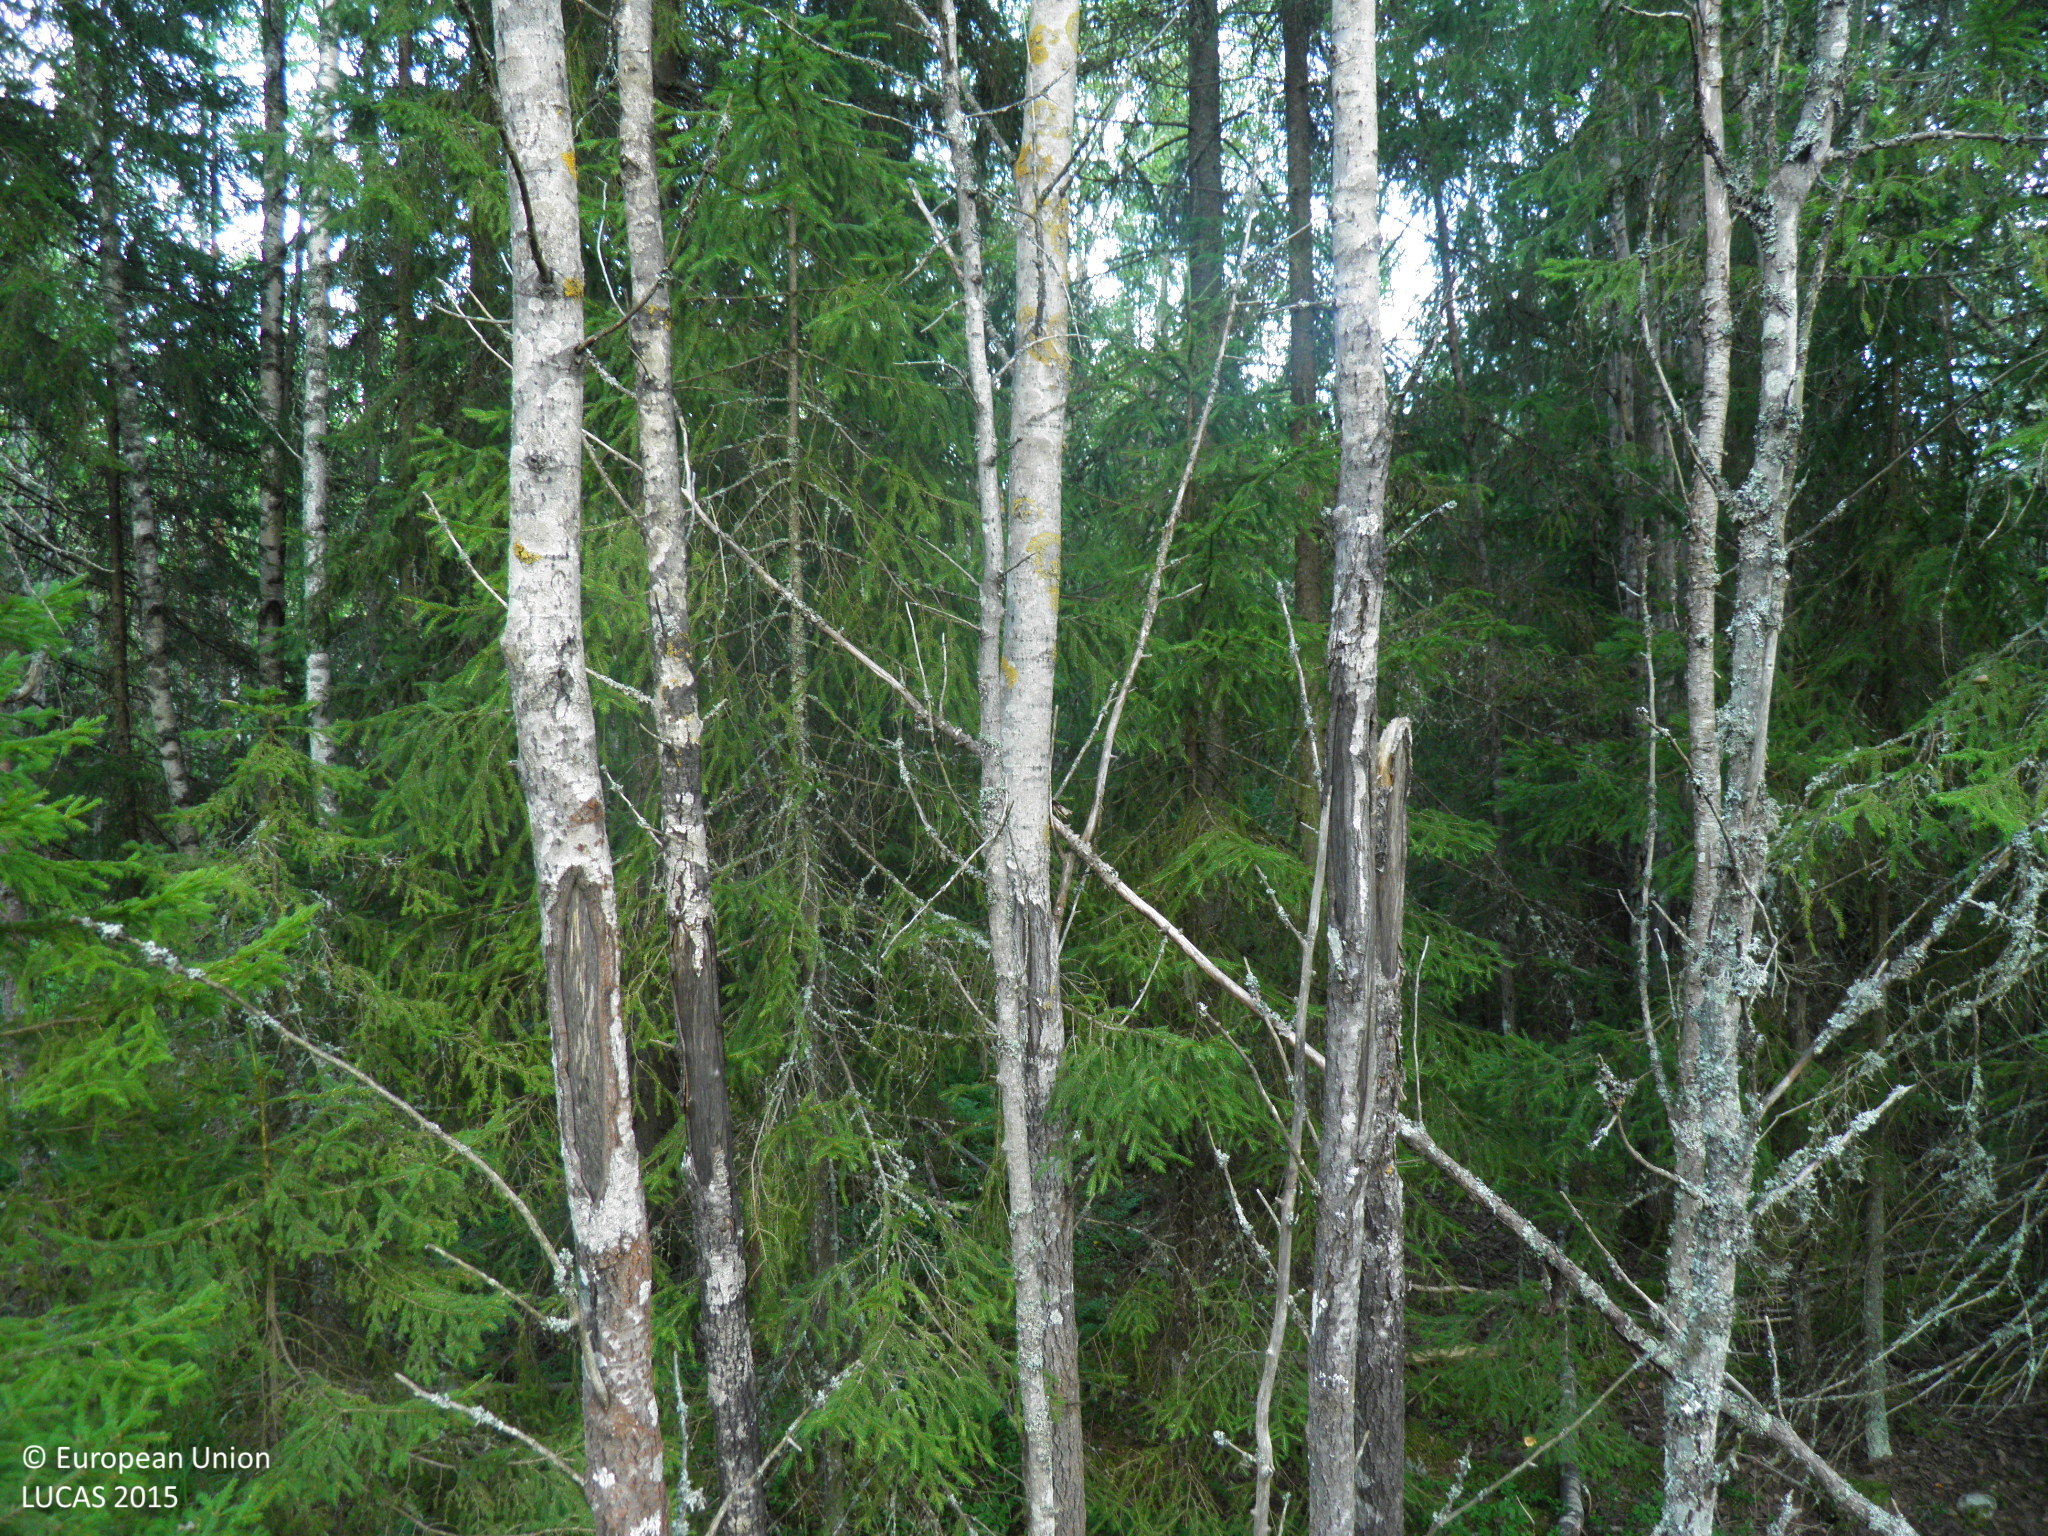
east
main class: Woodland
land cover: Pine dominated mixed woodland
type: hemiboreal forest and nemoral coniferous forest and mixed broadleaved-coniferous forest
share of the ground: 50 - 75 %
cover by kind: coniferous forest trees 30 %, lichens and mosses 30 %, broadleaved forest trees 20 %, shrubs 20 %
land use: Forestry
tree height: > 5 m
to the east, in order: Pine dominated mixed woodland; Spruce dominated mixed woodland; Ditches and canals; Tracks; Ditches and canals; Spruce dominated mixed woodland; Ditches and canals; Spruce dominated mixed woodland; Other mixed woodland; Tracks; Other mixed woodland
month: August
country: FI
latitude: 61.1680
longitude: 22.5773
